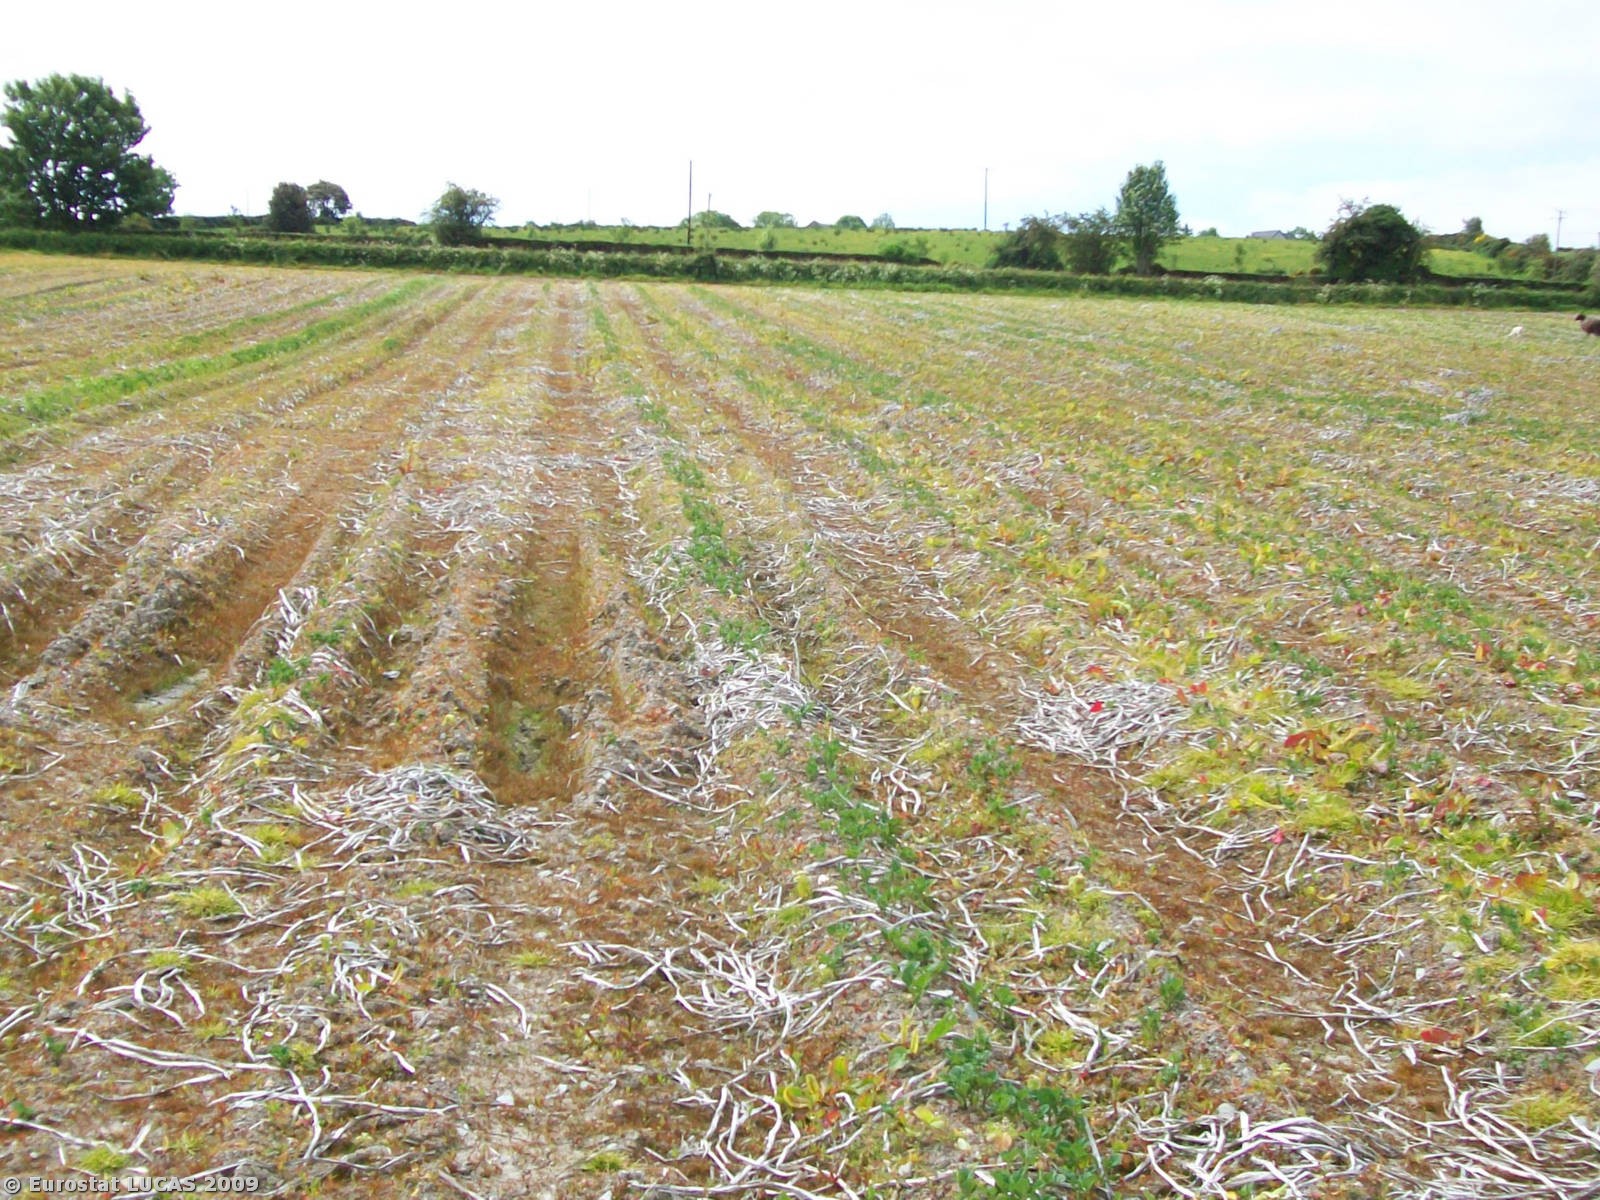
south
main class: Cropland
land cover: Potatoes
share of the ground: > 75 %
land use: Agriculture (excluding fallow land and kitchen gardens)
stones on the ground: < 10 %
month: June
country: GB
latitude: 55.0289
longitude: -7.0831
